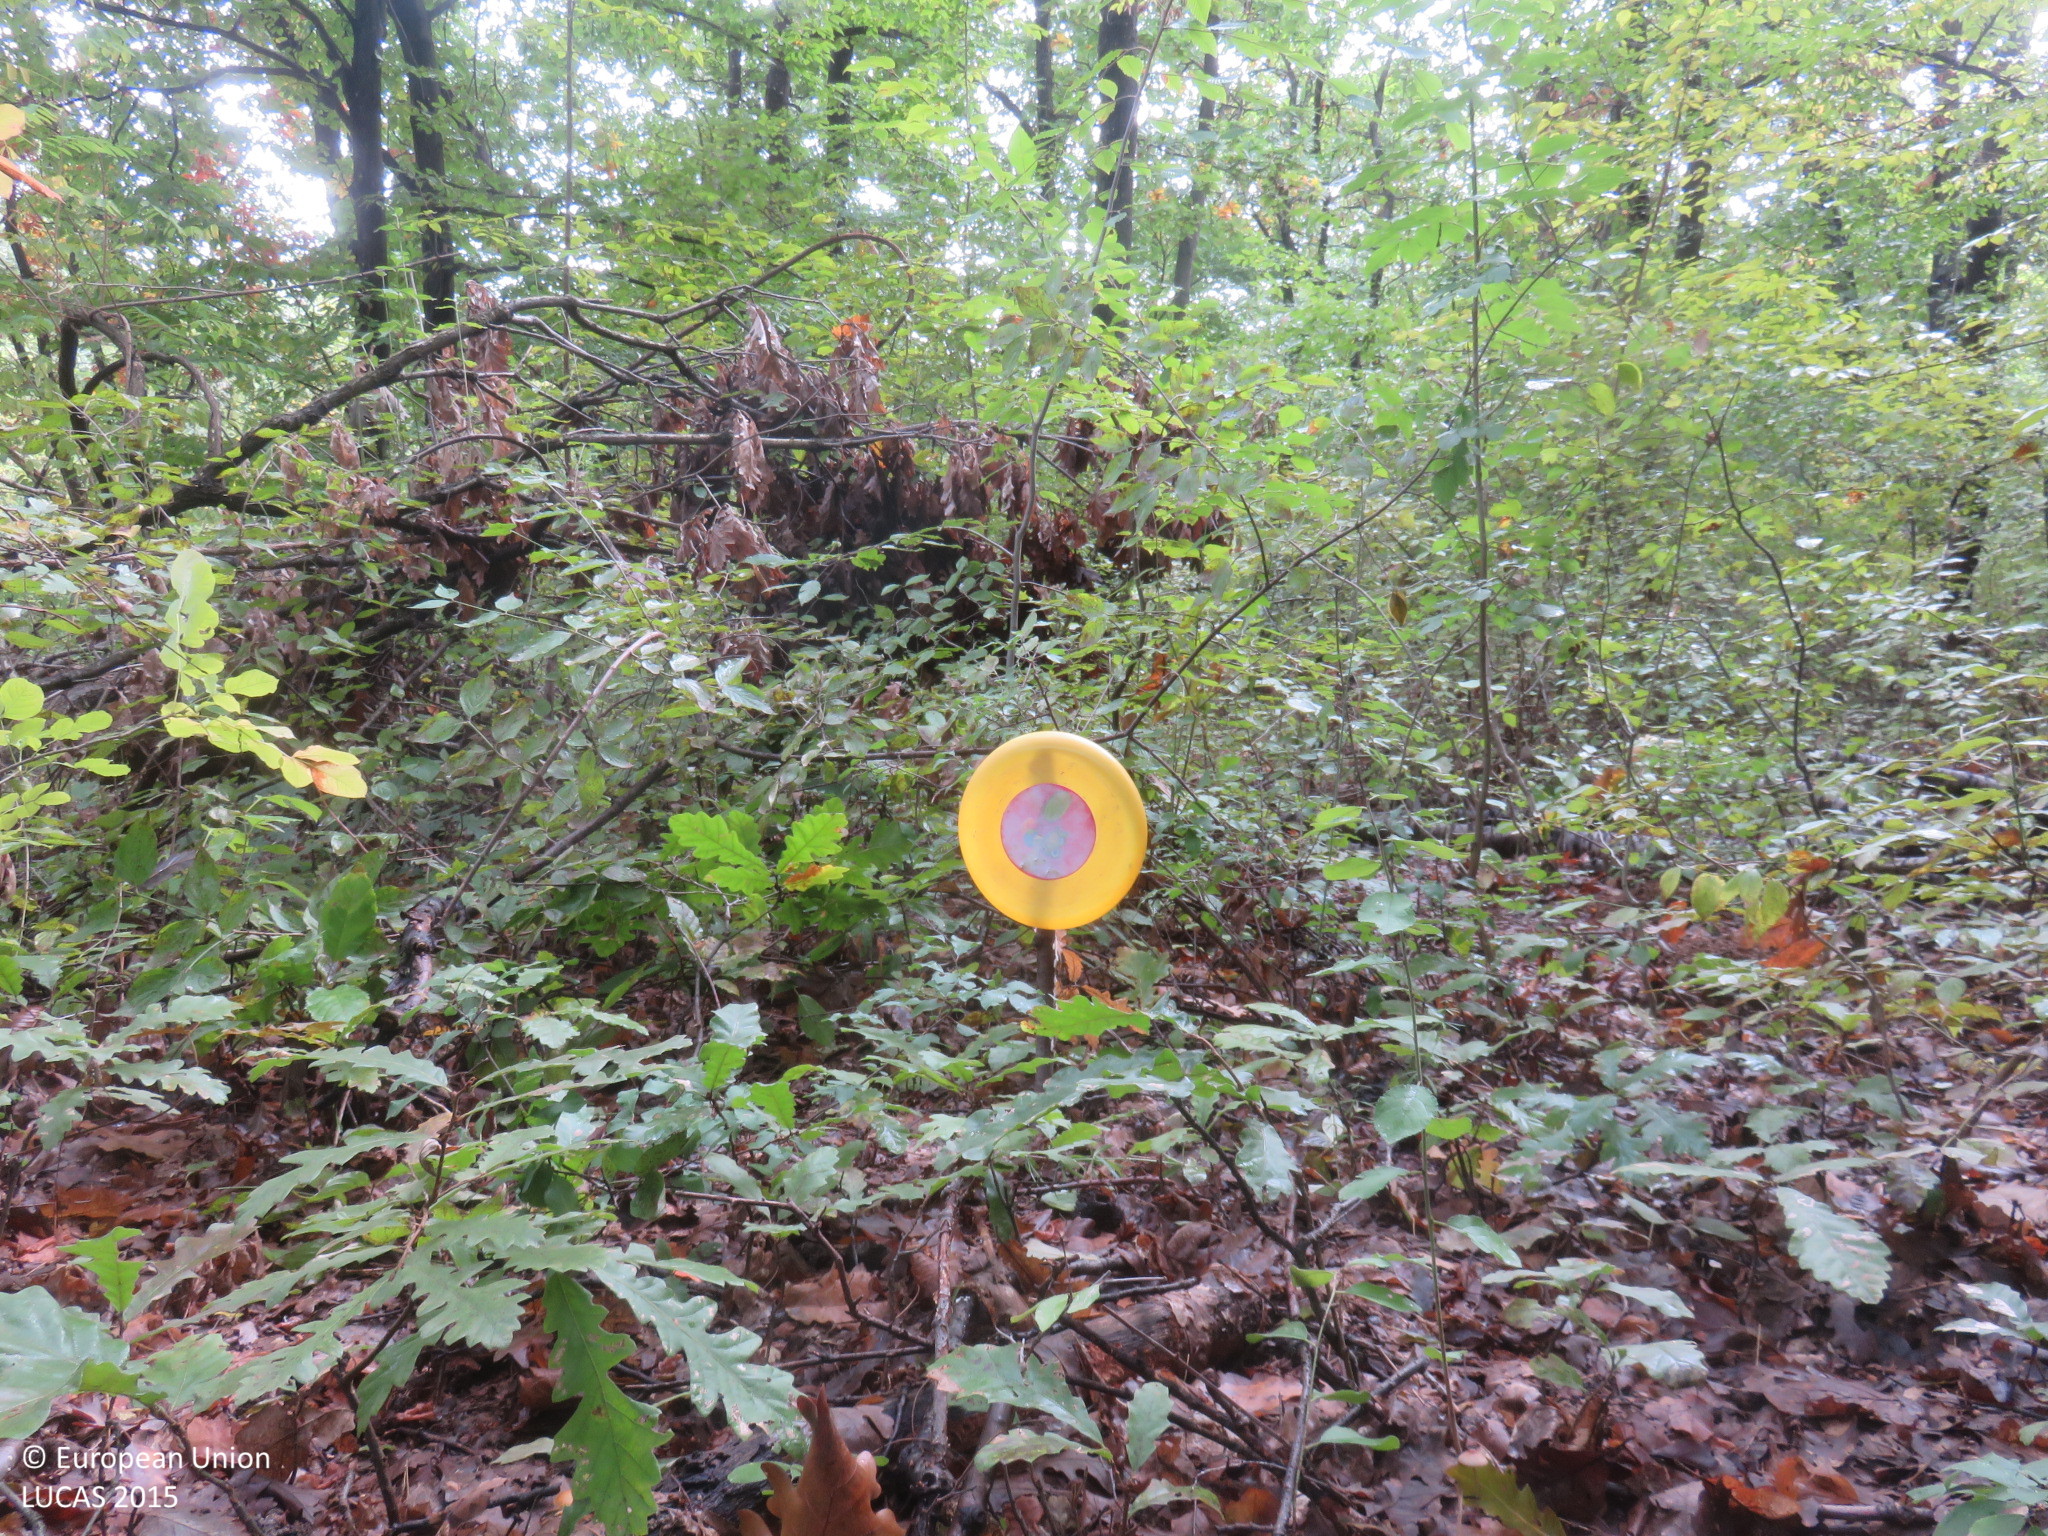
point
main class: Woodland
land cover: Broadleaved woodland
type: mesophytic deciduous forest
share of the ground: > 75 %
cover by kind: broadleaved forest trees 95 %, shrubs 5 %
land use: Forestry
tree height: < 5 m
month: October
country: BG
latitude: 43.0566
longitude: 25.2094
